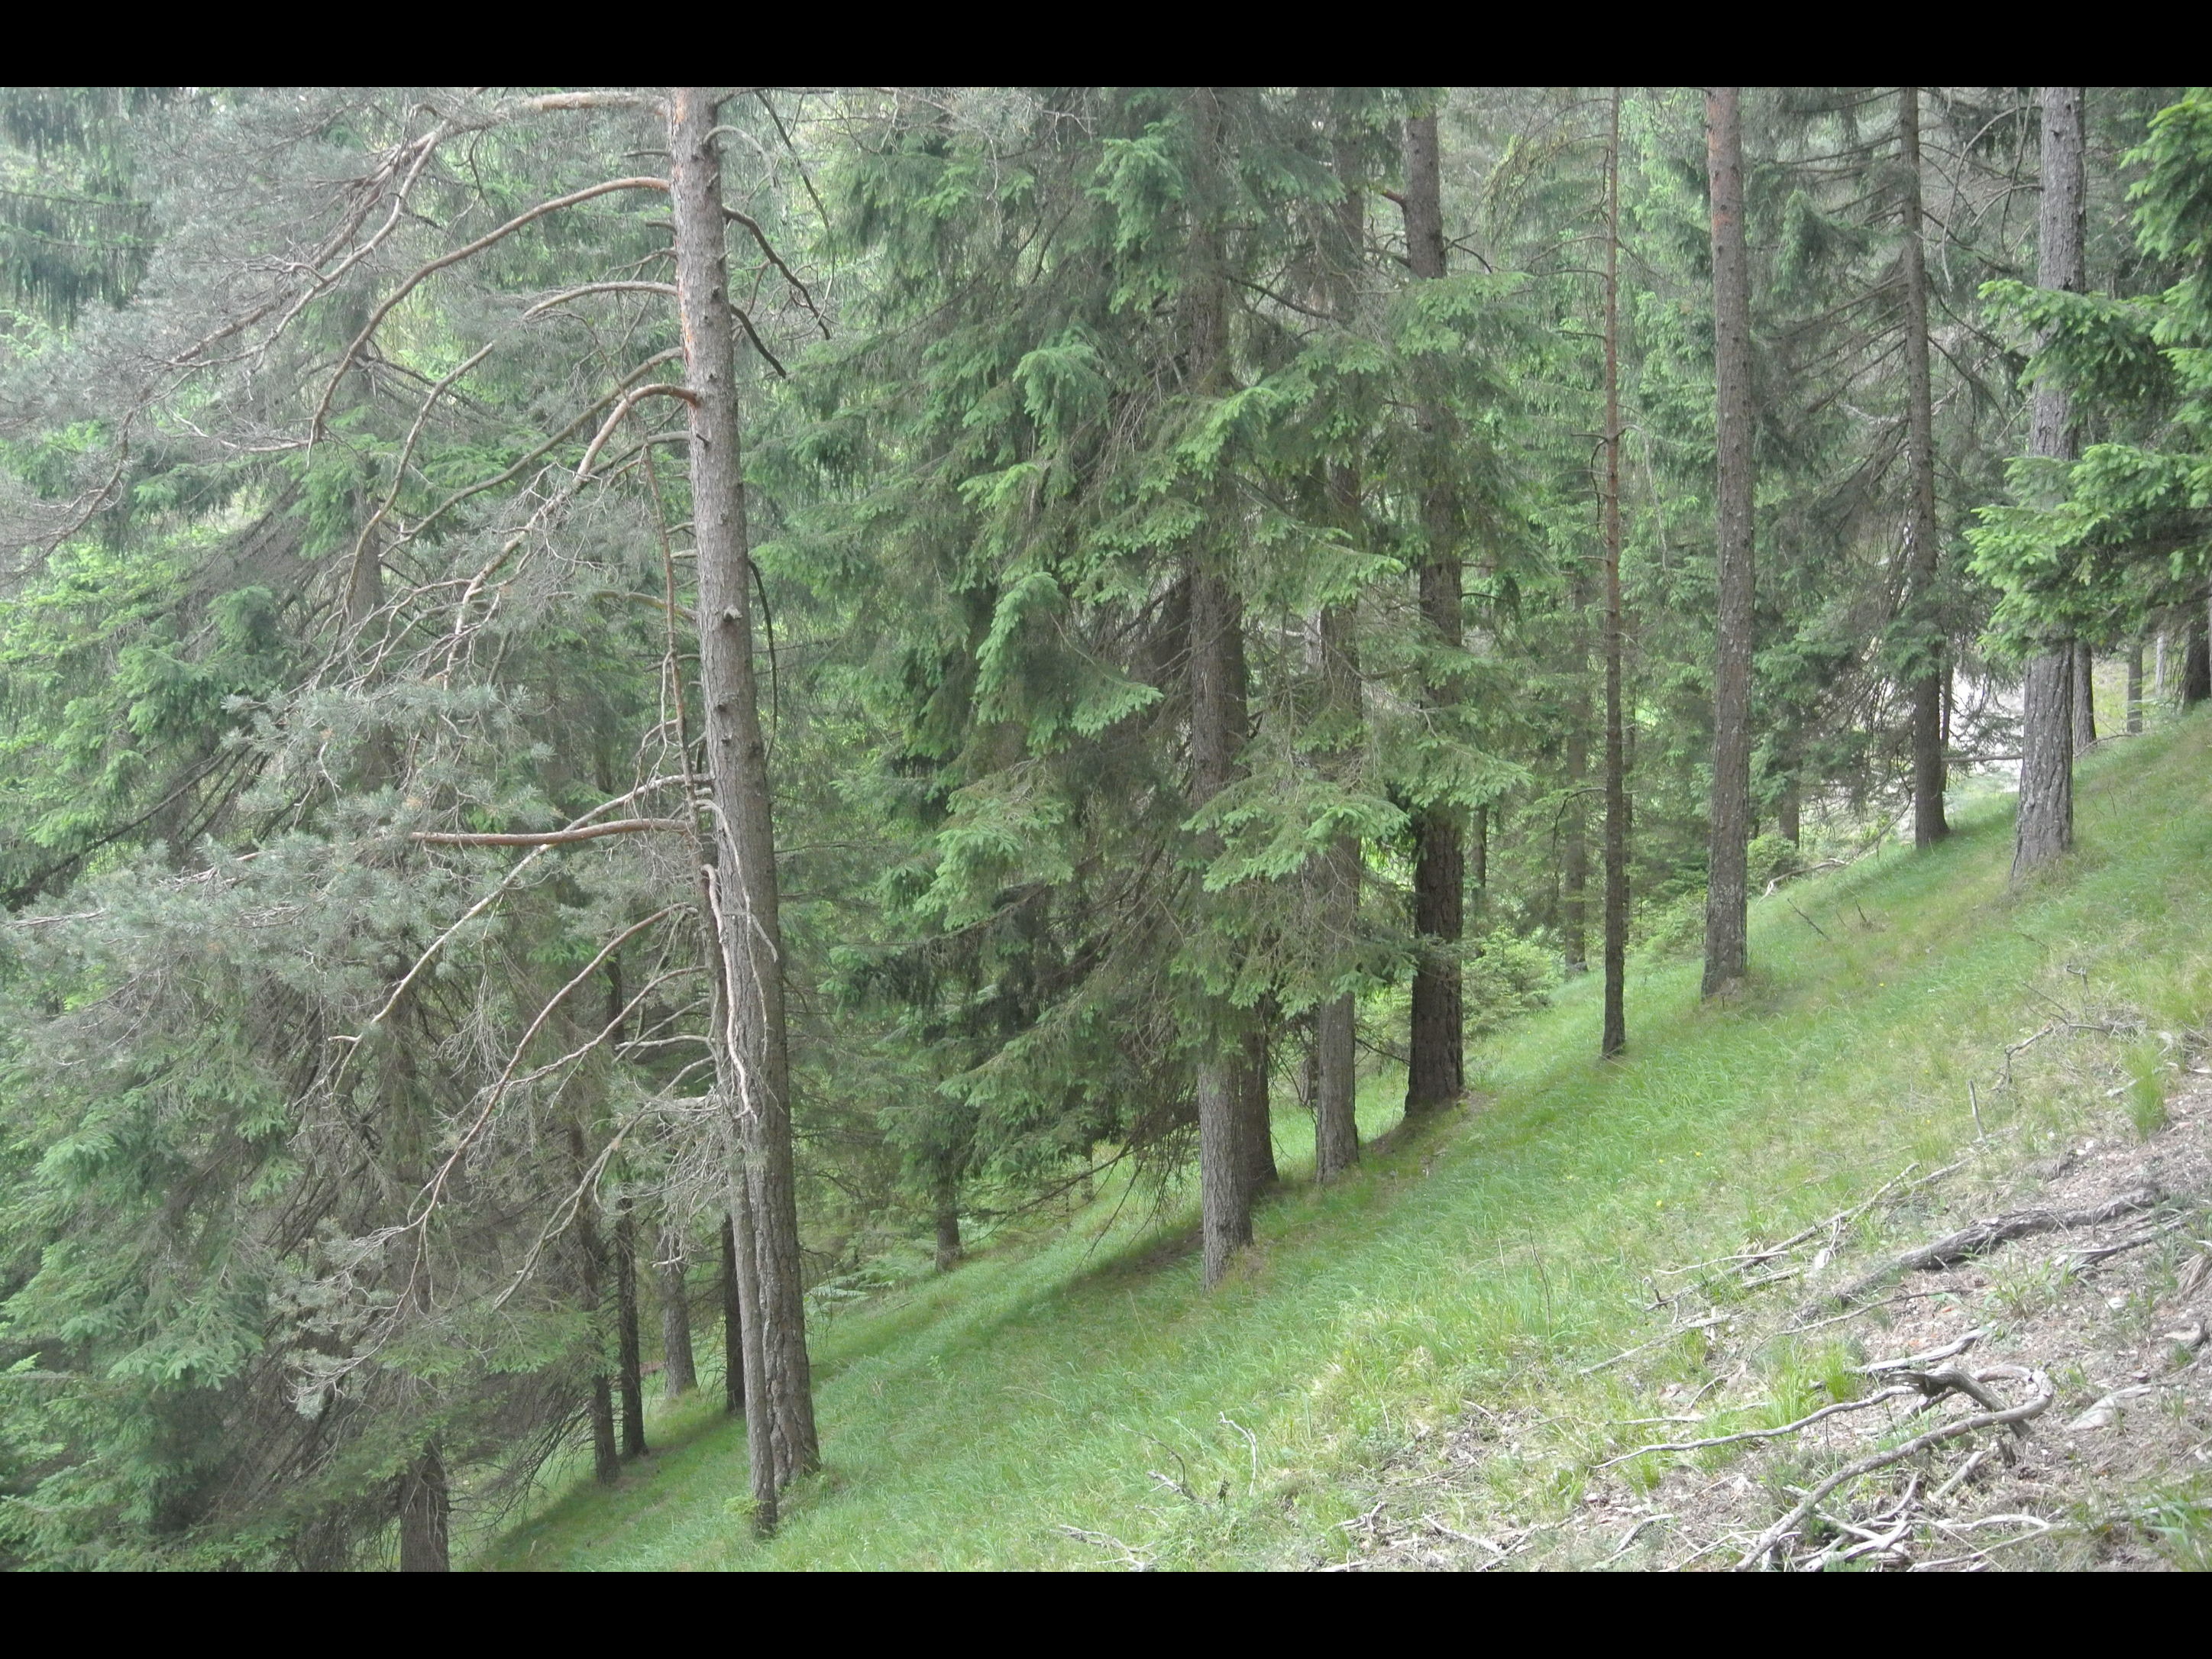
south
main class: Woodland
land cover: Pine dominated coniferous woodland
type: alpine coniferous forest
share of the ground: > 75 %
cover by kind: coniferous forest trees 100 %
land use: Forestry
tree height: > 5 m
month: June
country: AT
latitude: 47.8521
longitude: 15.8429
